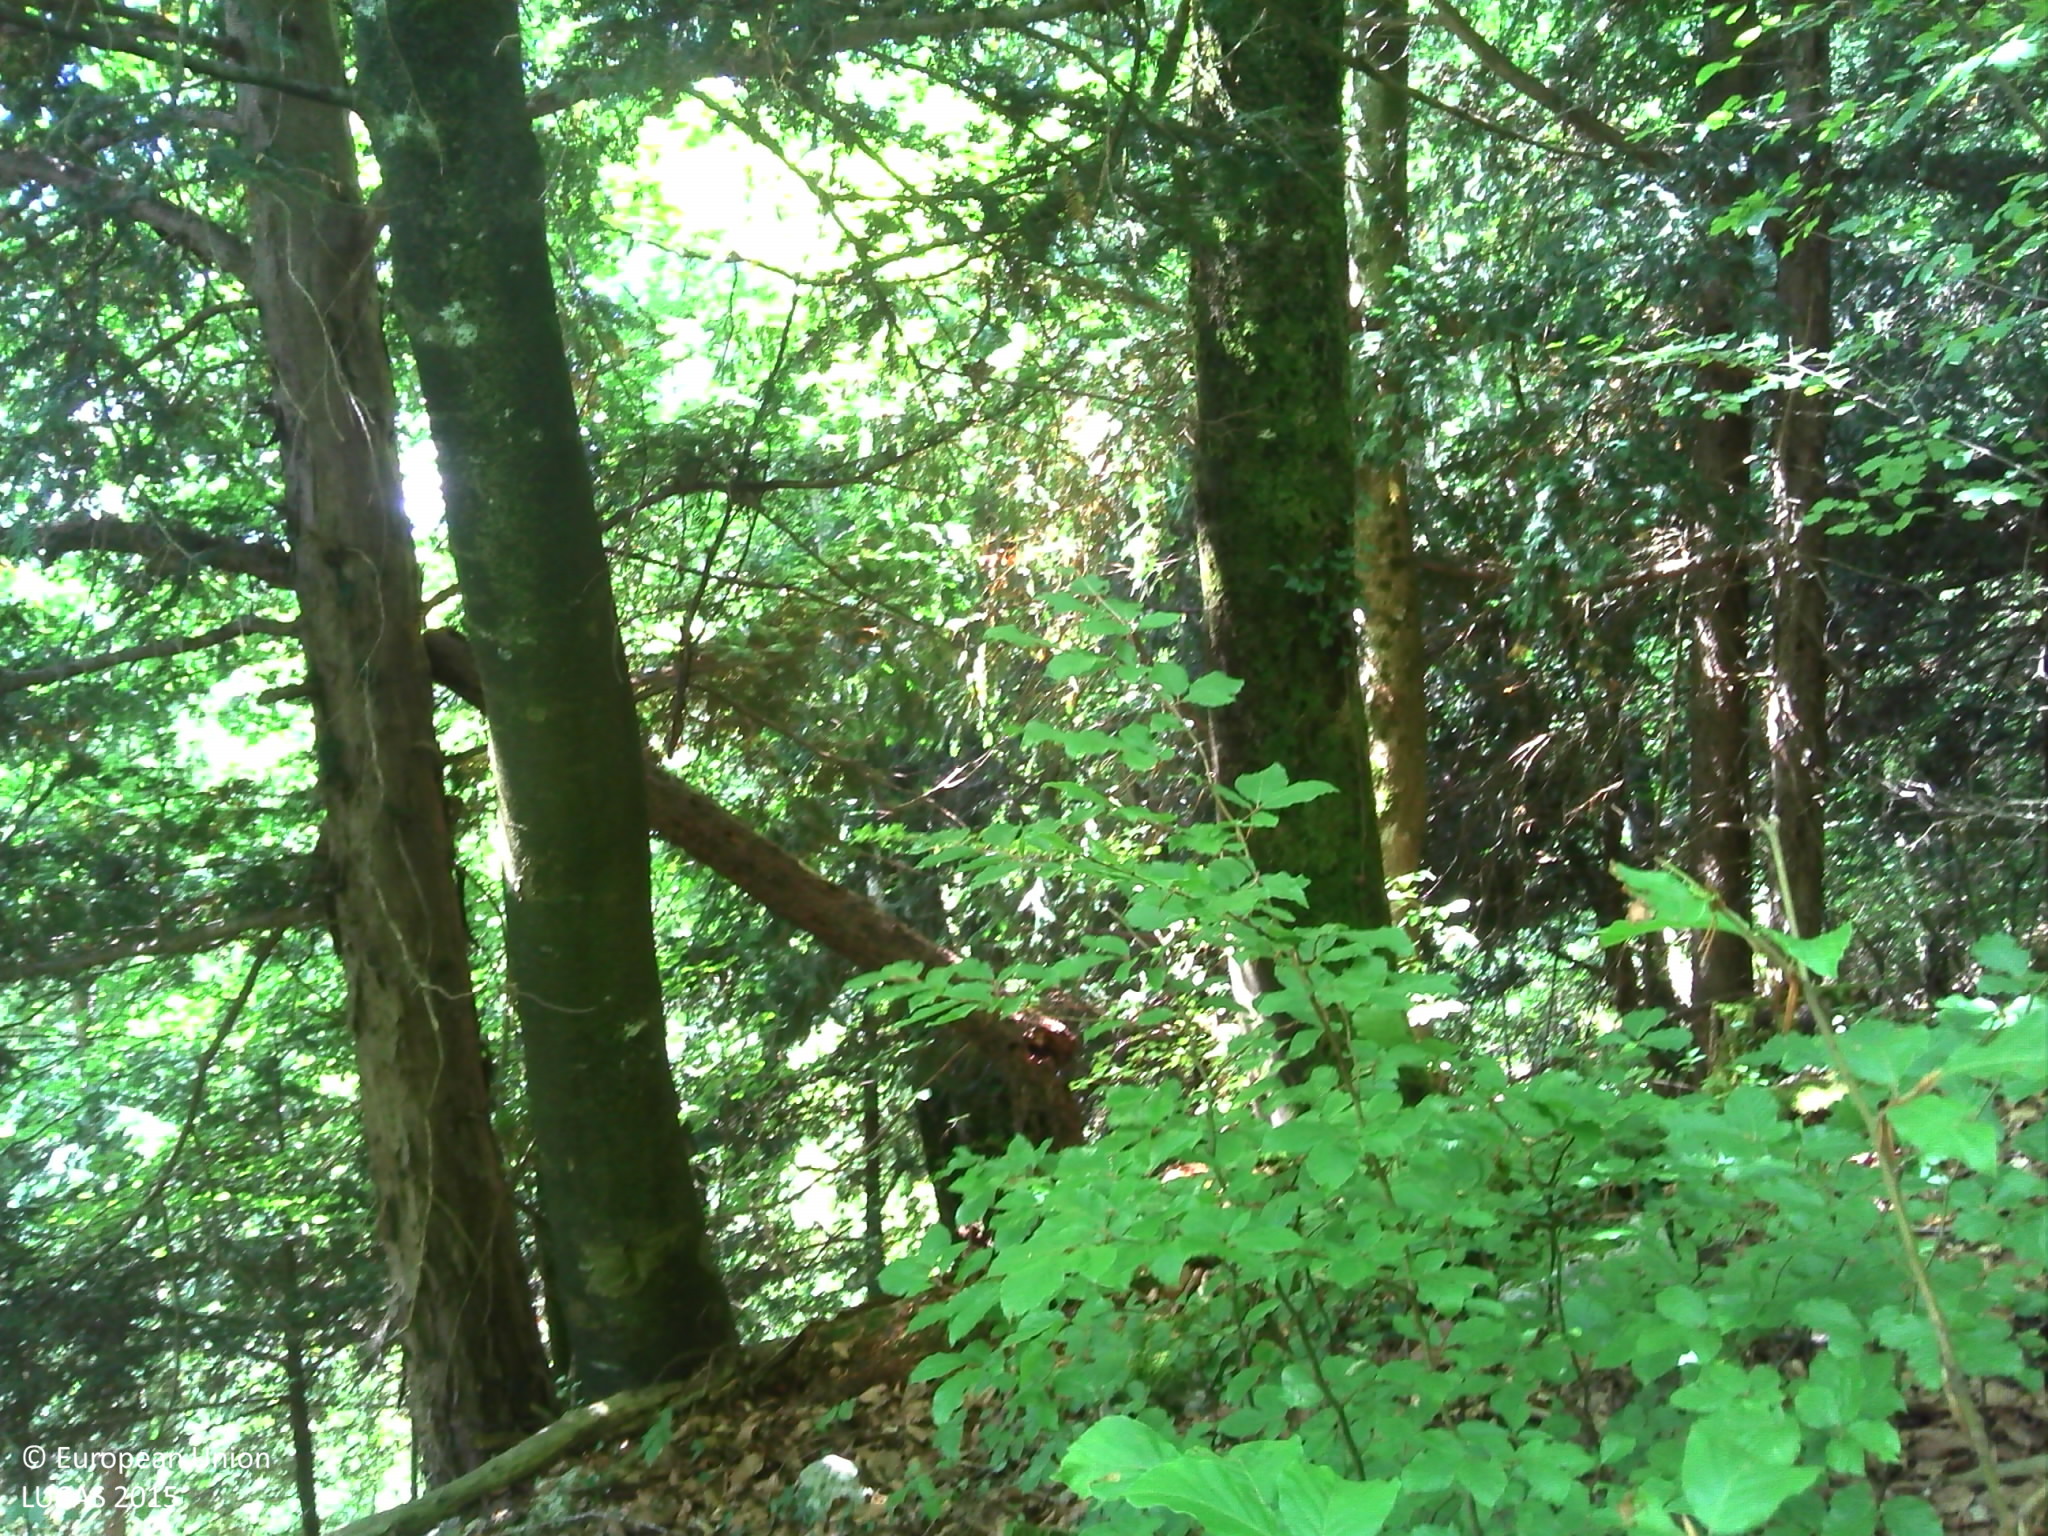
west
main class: Woodland
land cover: Pine dominated mixed woodland
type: beech forest
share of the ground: > 75 %
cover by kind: coniferous forest trees 40 %, broadleaved forest trees 35 %, herbaceous plants 20 %, lichens and mosses 5 %
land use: Forestry
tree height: > 5 m
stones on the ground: > 50 %
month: July
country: FR
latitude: 46.0930
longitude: 6.4209
